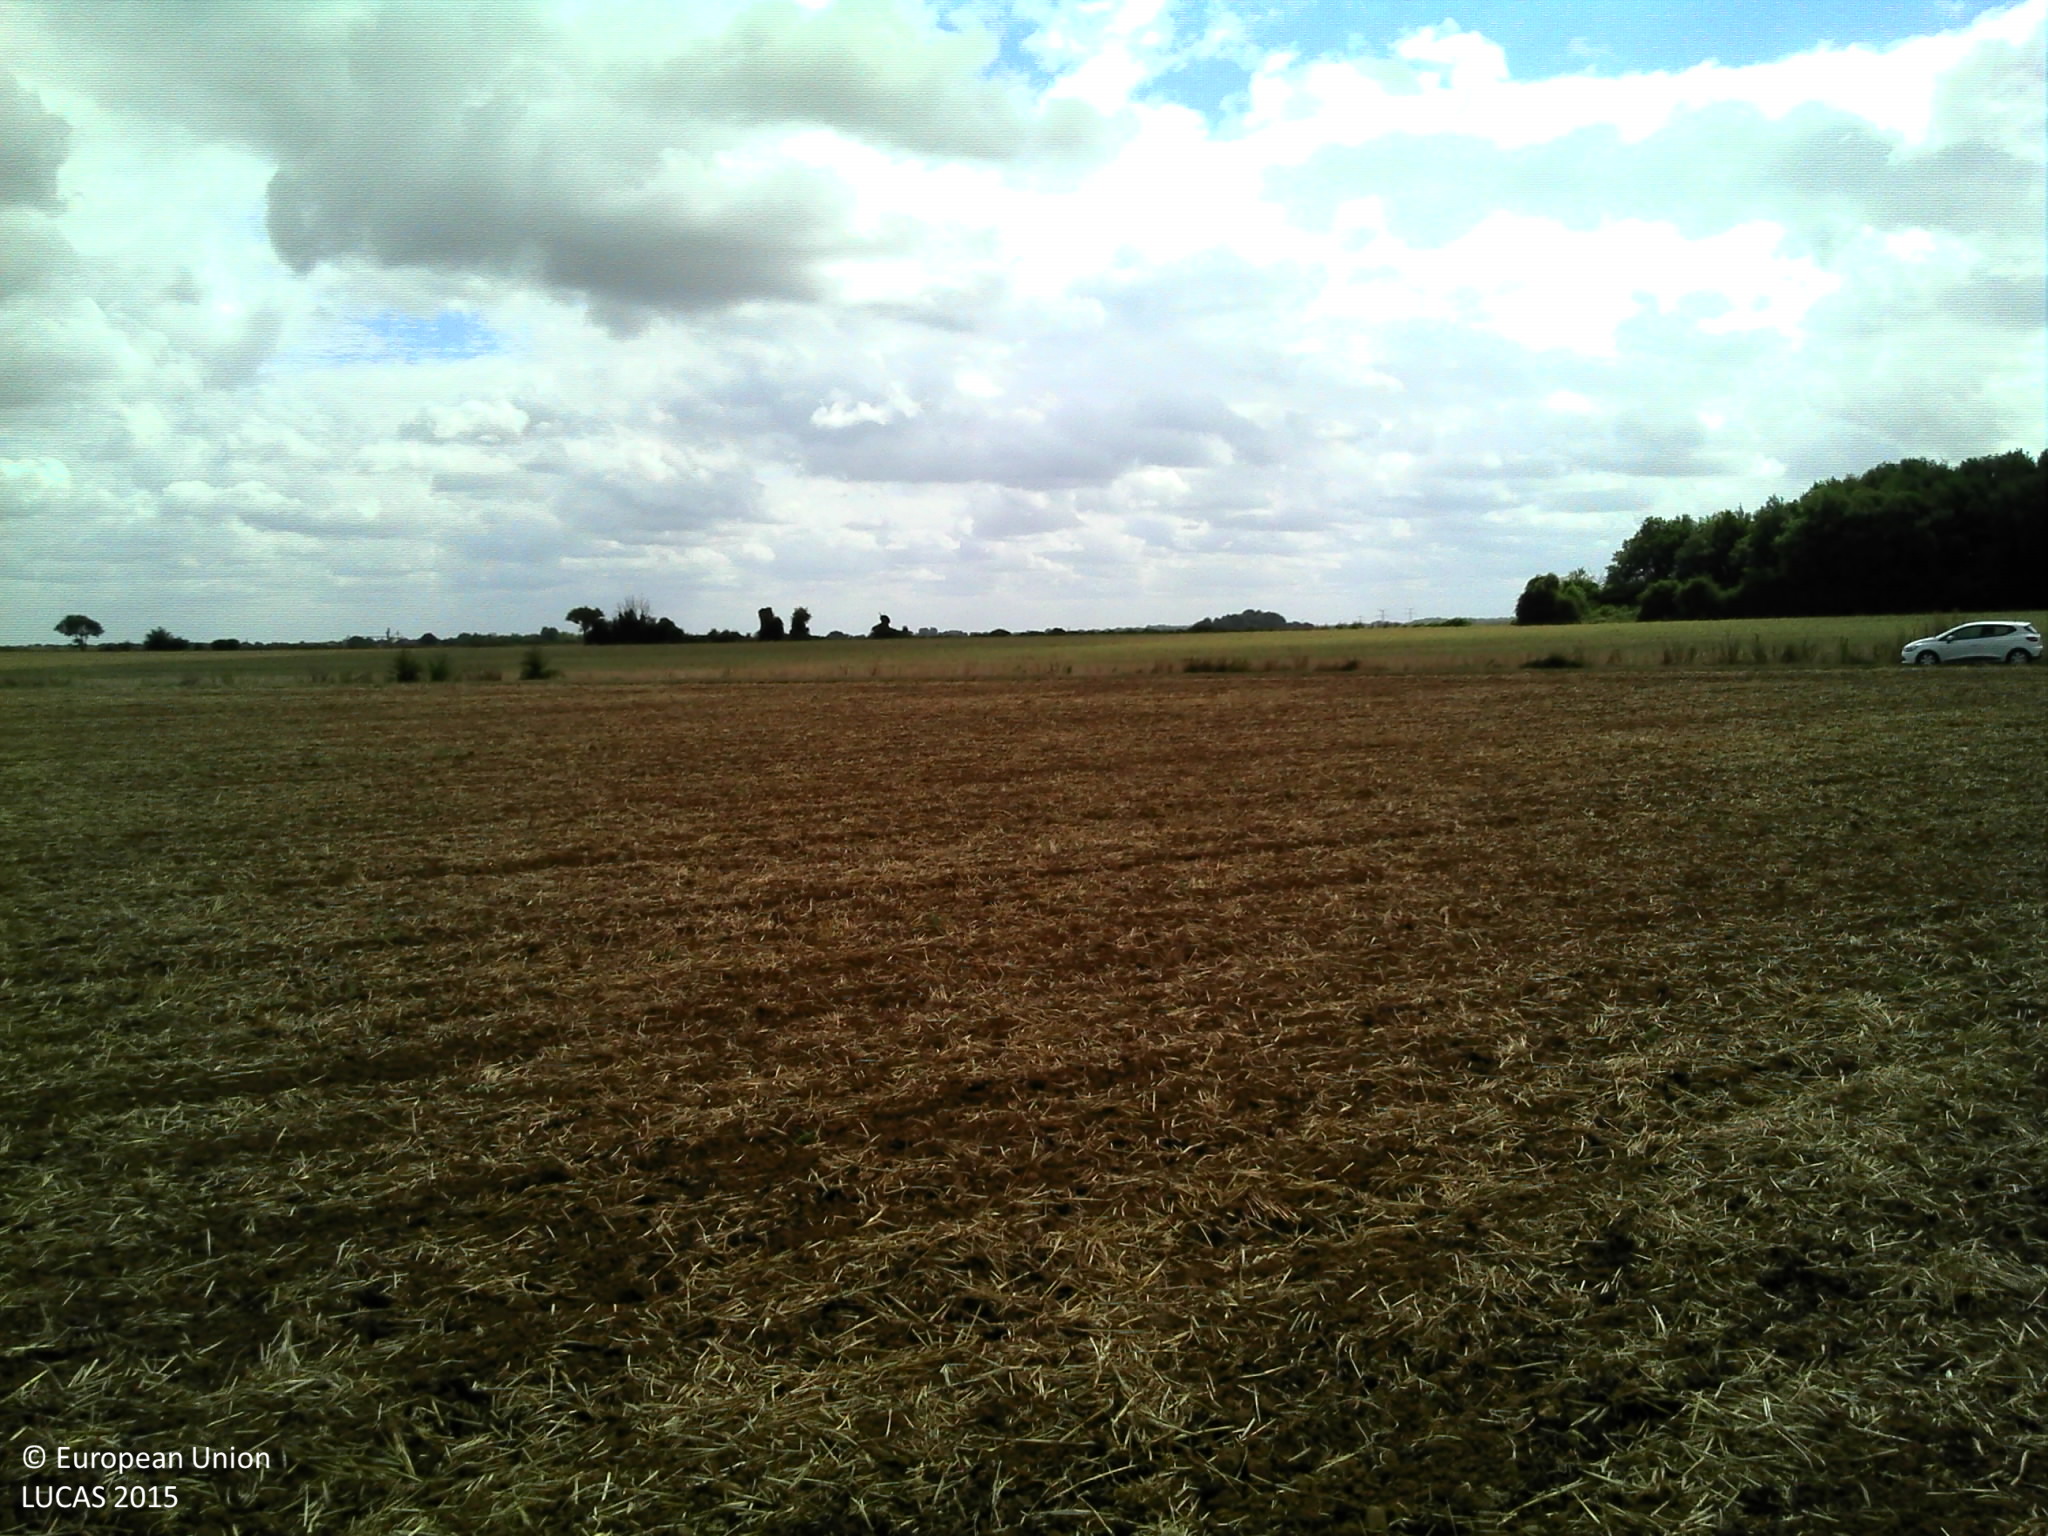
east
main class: Cropland
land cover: Barley
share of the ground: < 10 %
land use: Agriculture (excluding fallow land and kitchen gardens)
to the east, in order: Barley; Grass margins; Tracks; Grass margins; Rape and turnip rape
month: July
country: FR
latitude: 46.3912
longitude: 0.2144
